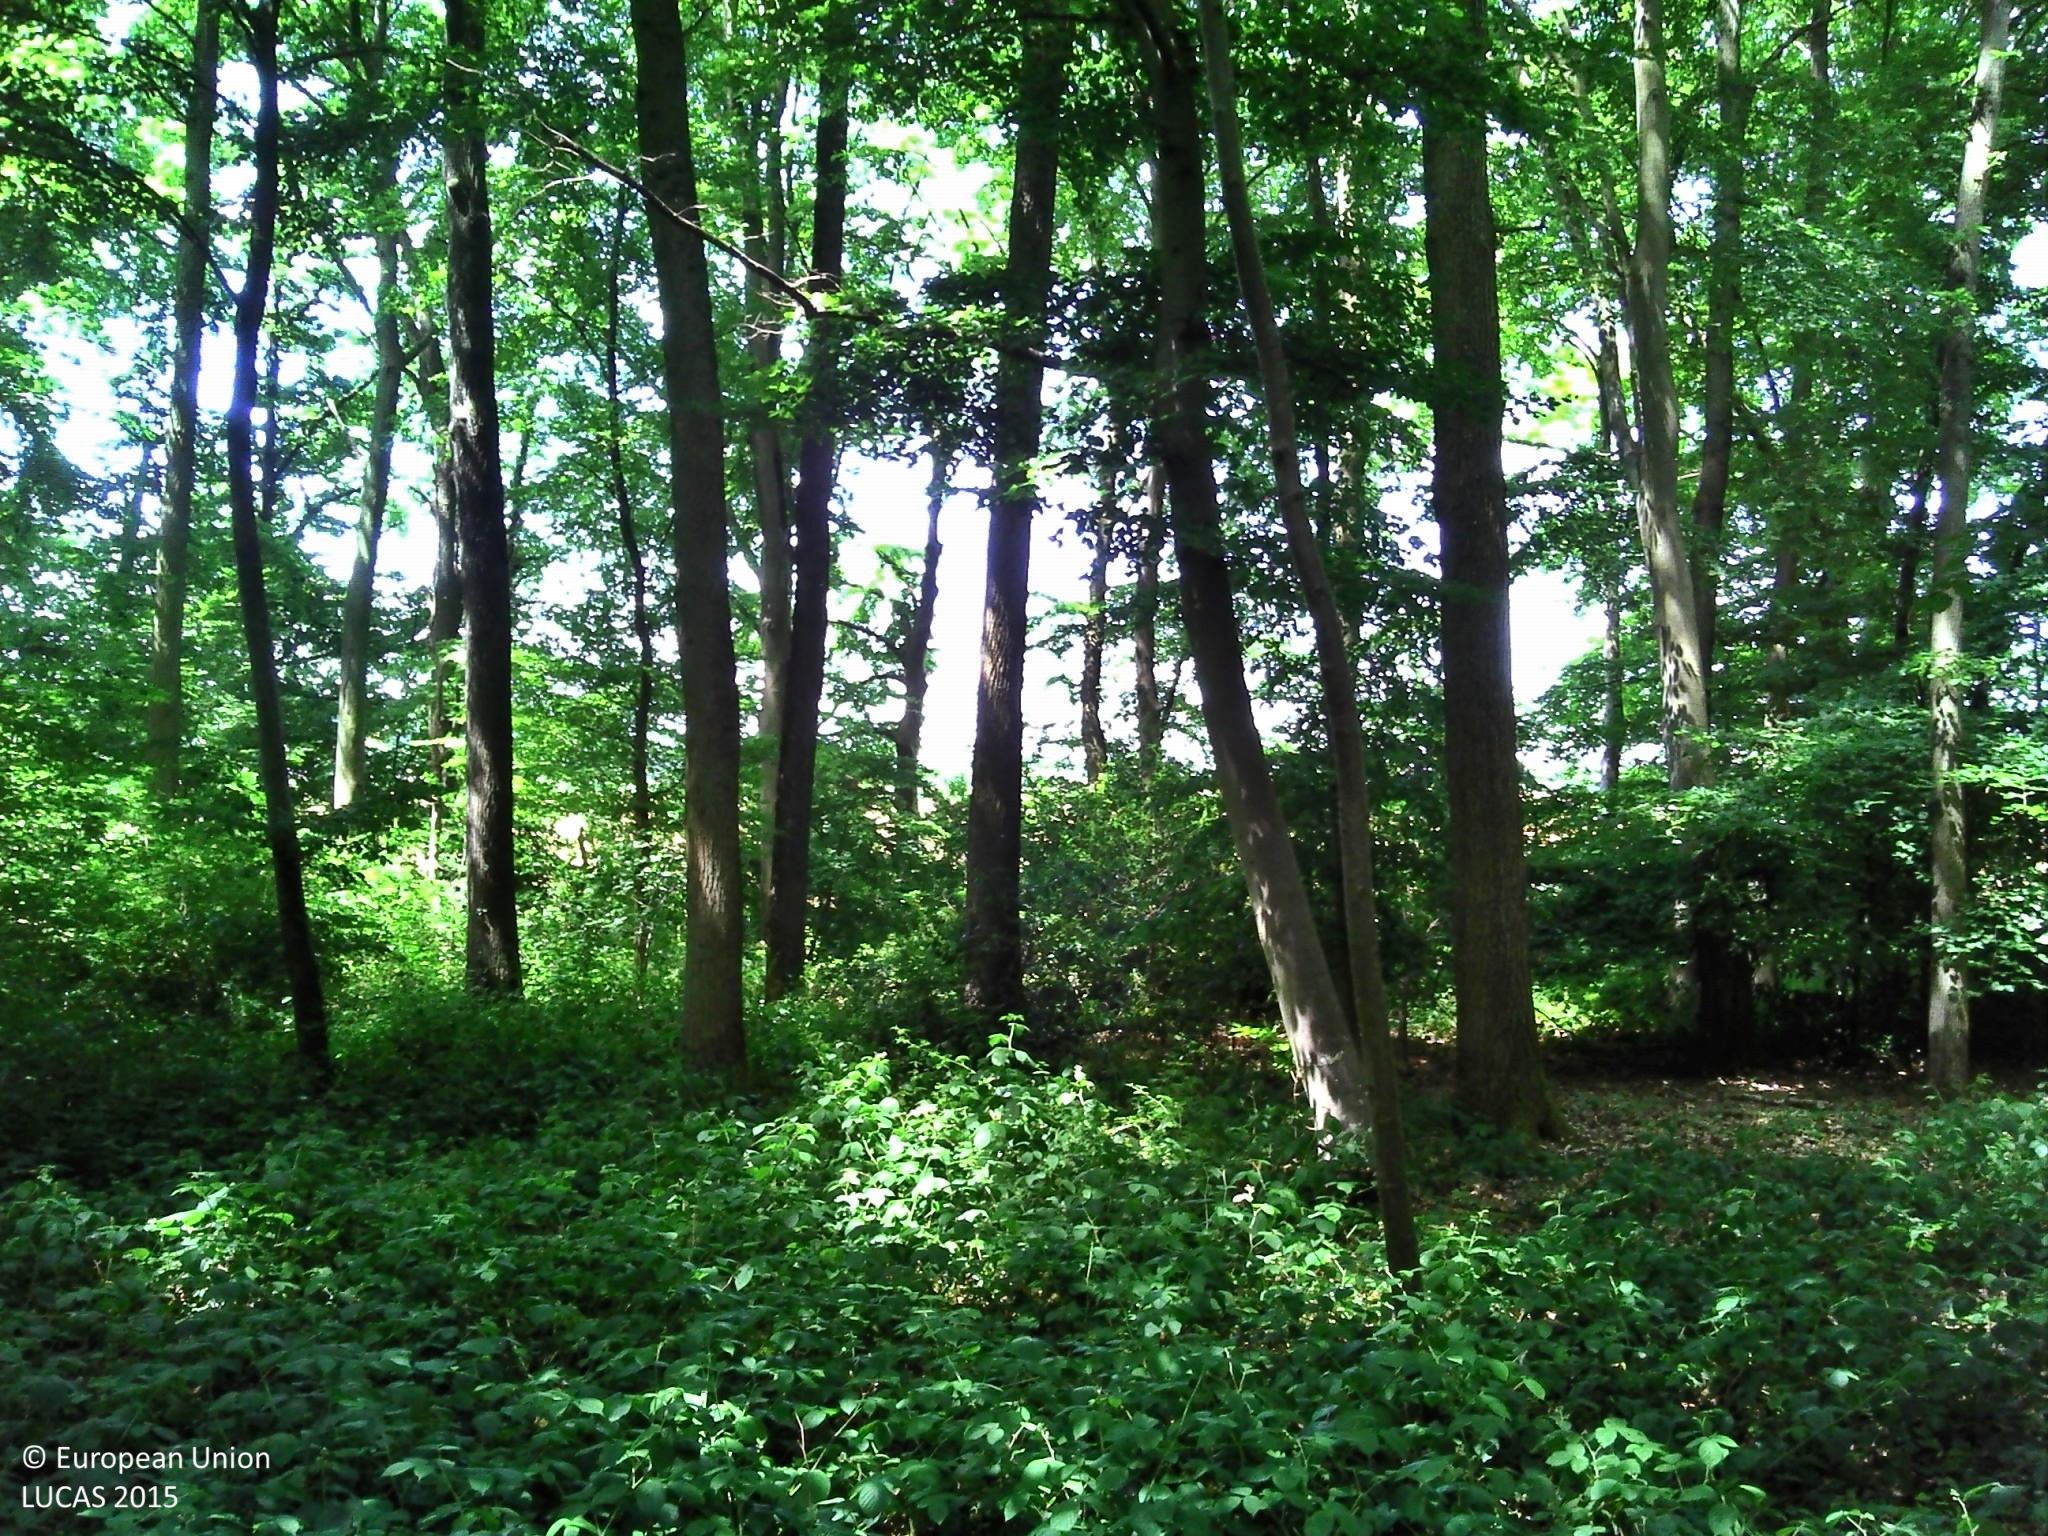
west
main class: Woodland
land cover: Broadleaved woodland
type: beech forest
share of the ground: > 75 %
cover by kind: broadleaved forest trees 80 %, herbaceous plants 15 %, shrubs 5 %
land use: Forestry
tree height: > 5 m
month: June
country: FR
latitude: 49.5218
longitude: 2.2367
